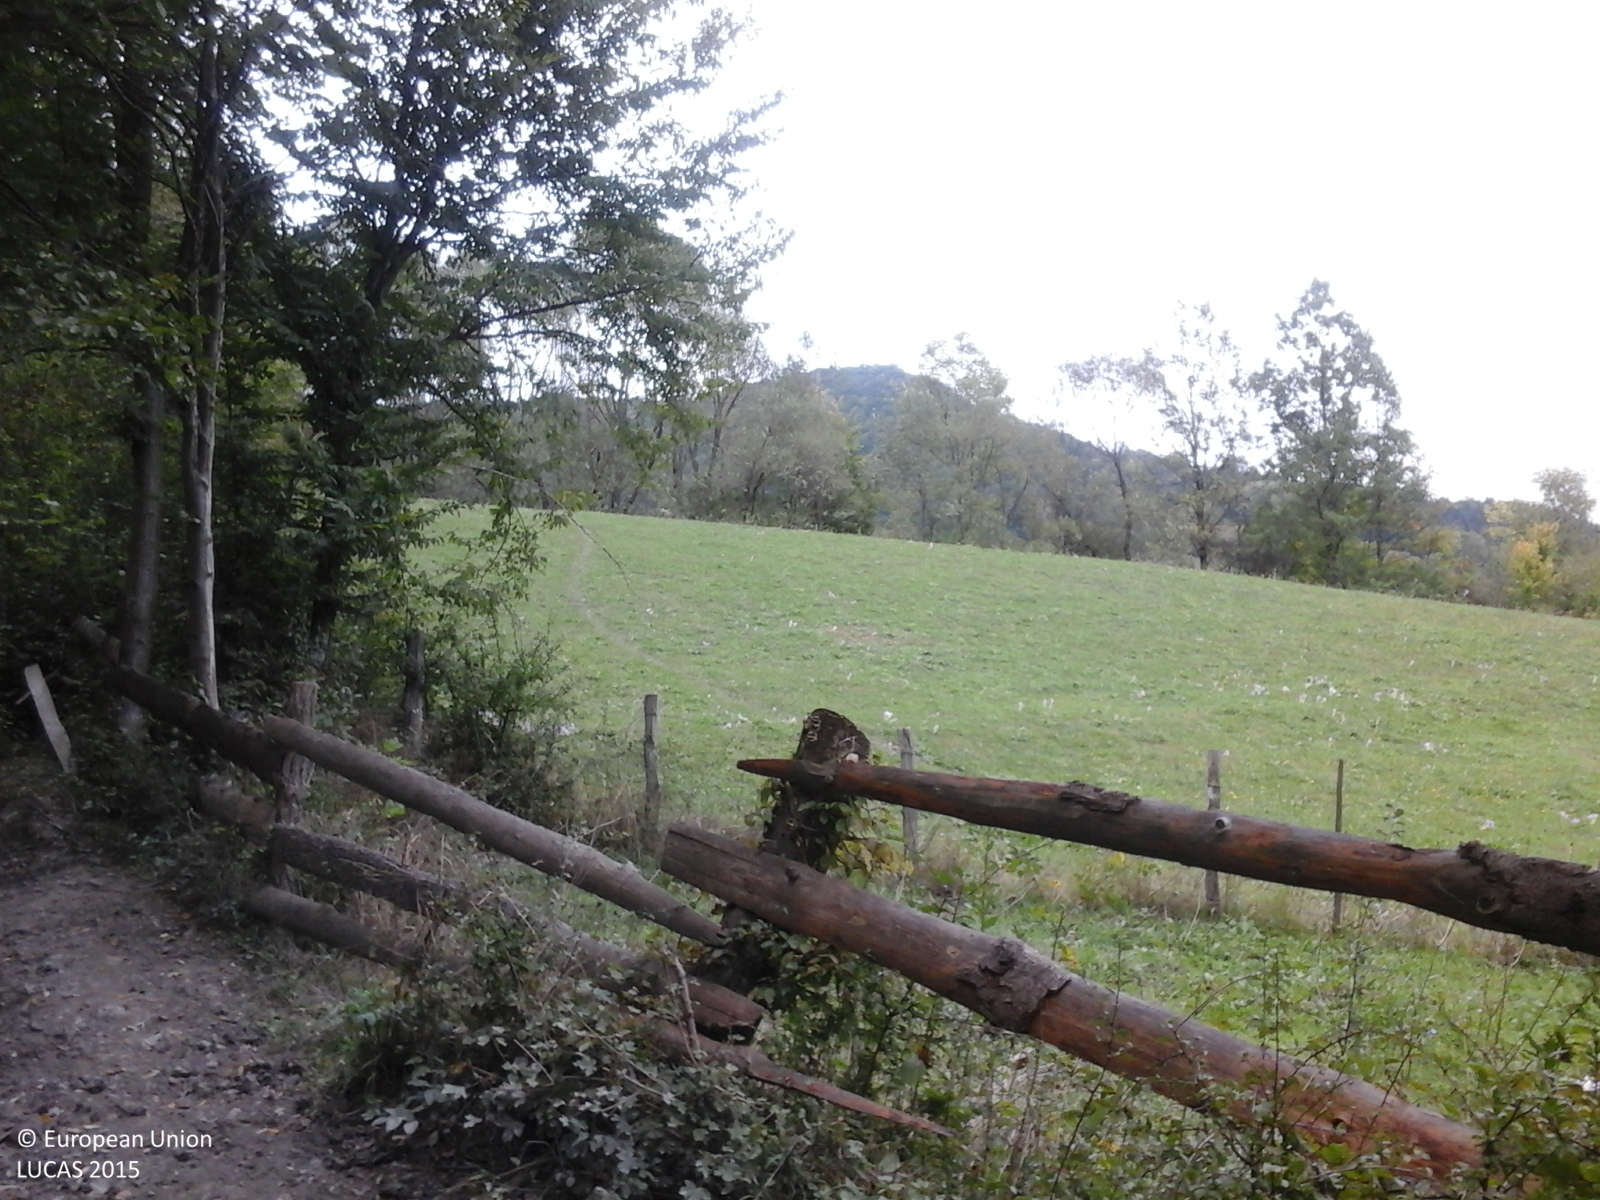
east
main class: Woodland
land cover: Broadleaved woodland
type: broadleaved evergreen forest
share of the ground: > 75 %
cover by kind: broadleaved forest trees 100 %
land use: Forestry
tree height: > 5 m
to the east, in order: Broadleaved woodland; Fences; Grassland without tree/shrub cover; Fences; Abandoned hedges; Tracks; Abandoned hedges; Fences; Grassland without tree/shrub cover; Apple fruit; Fences; Grassland without tree/shrub cover
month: October
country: RO
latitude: 46.2741
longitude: 23.0746
